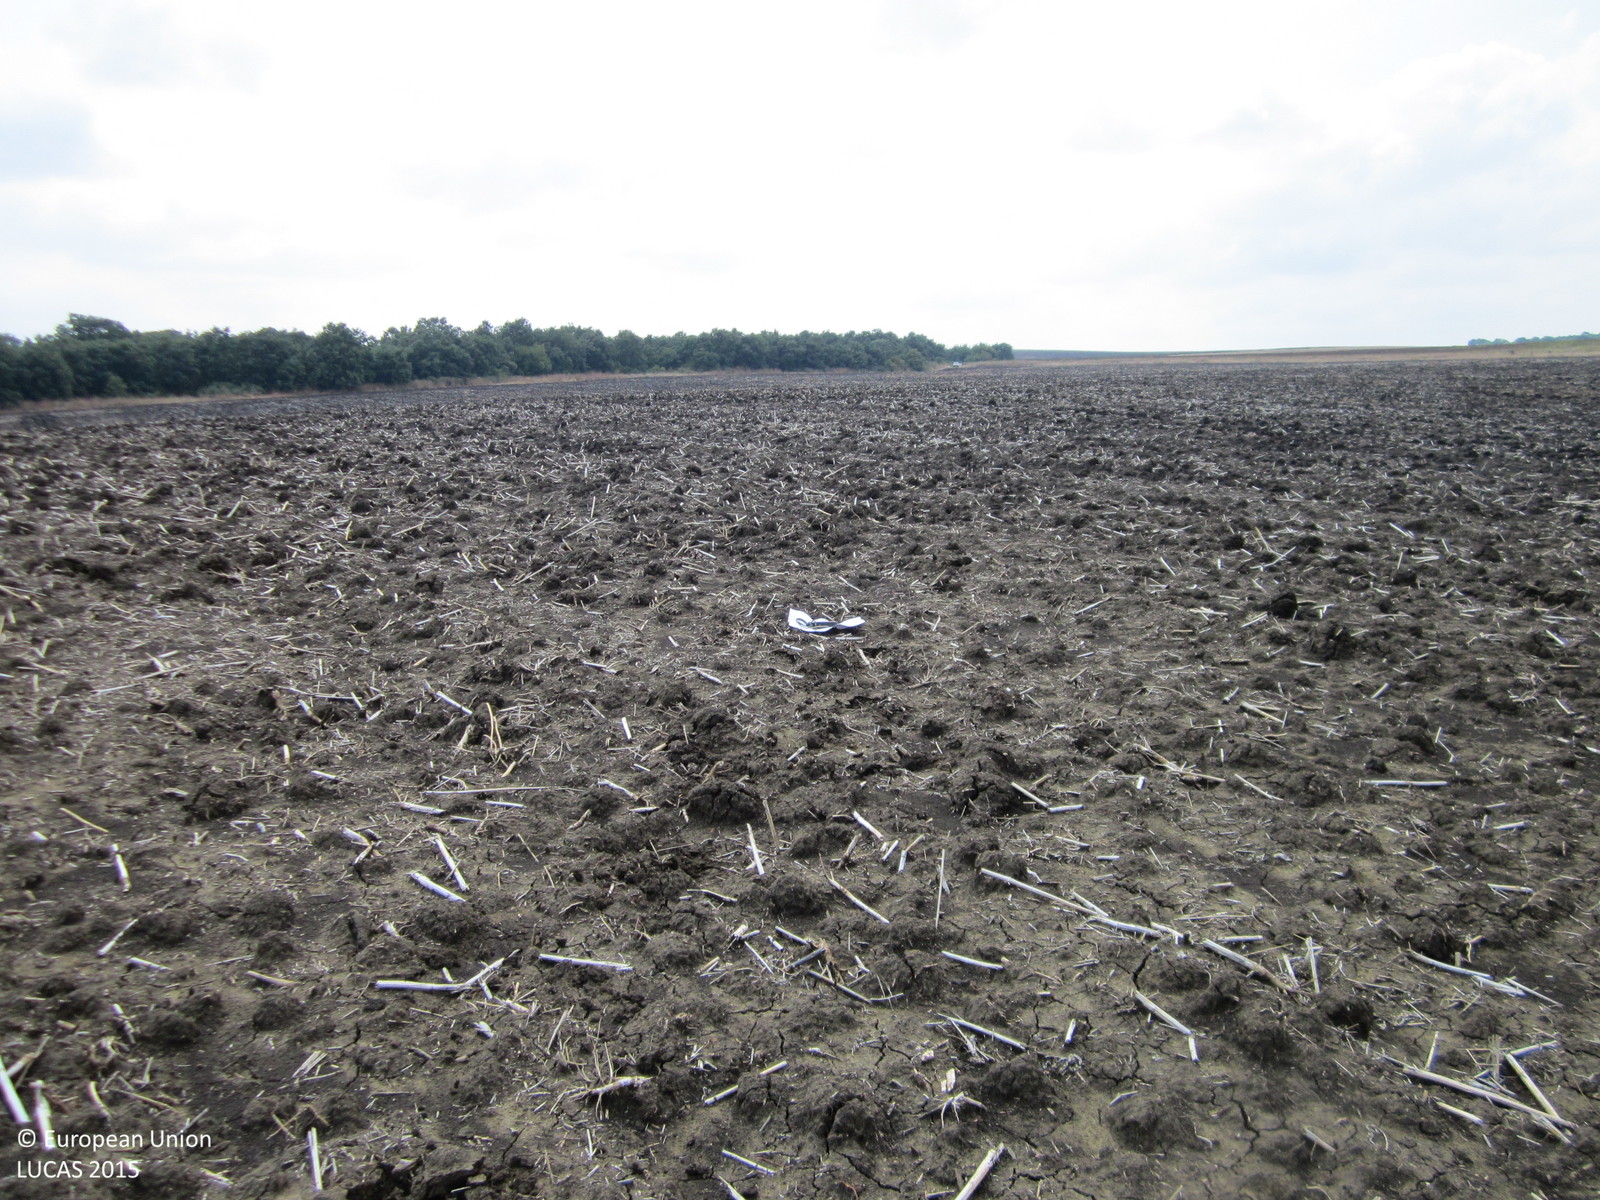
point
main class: Cropland
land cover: Sunflower
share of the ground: < 10 %
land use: Agriculture (excluding fallow land and kitchen gardens)
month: August
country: BG
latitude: 42.5048
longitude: 26.9334
